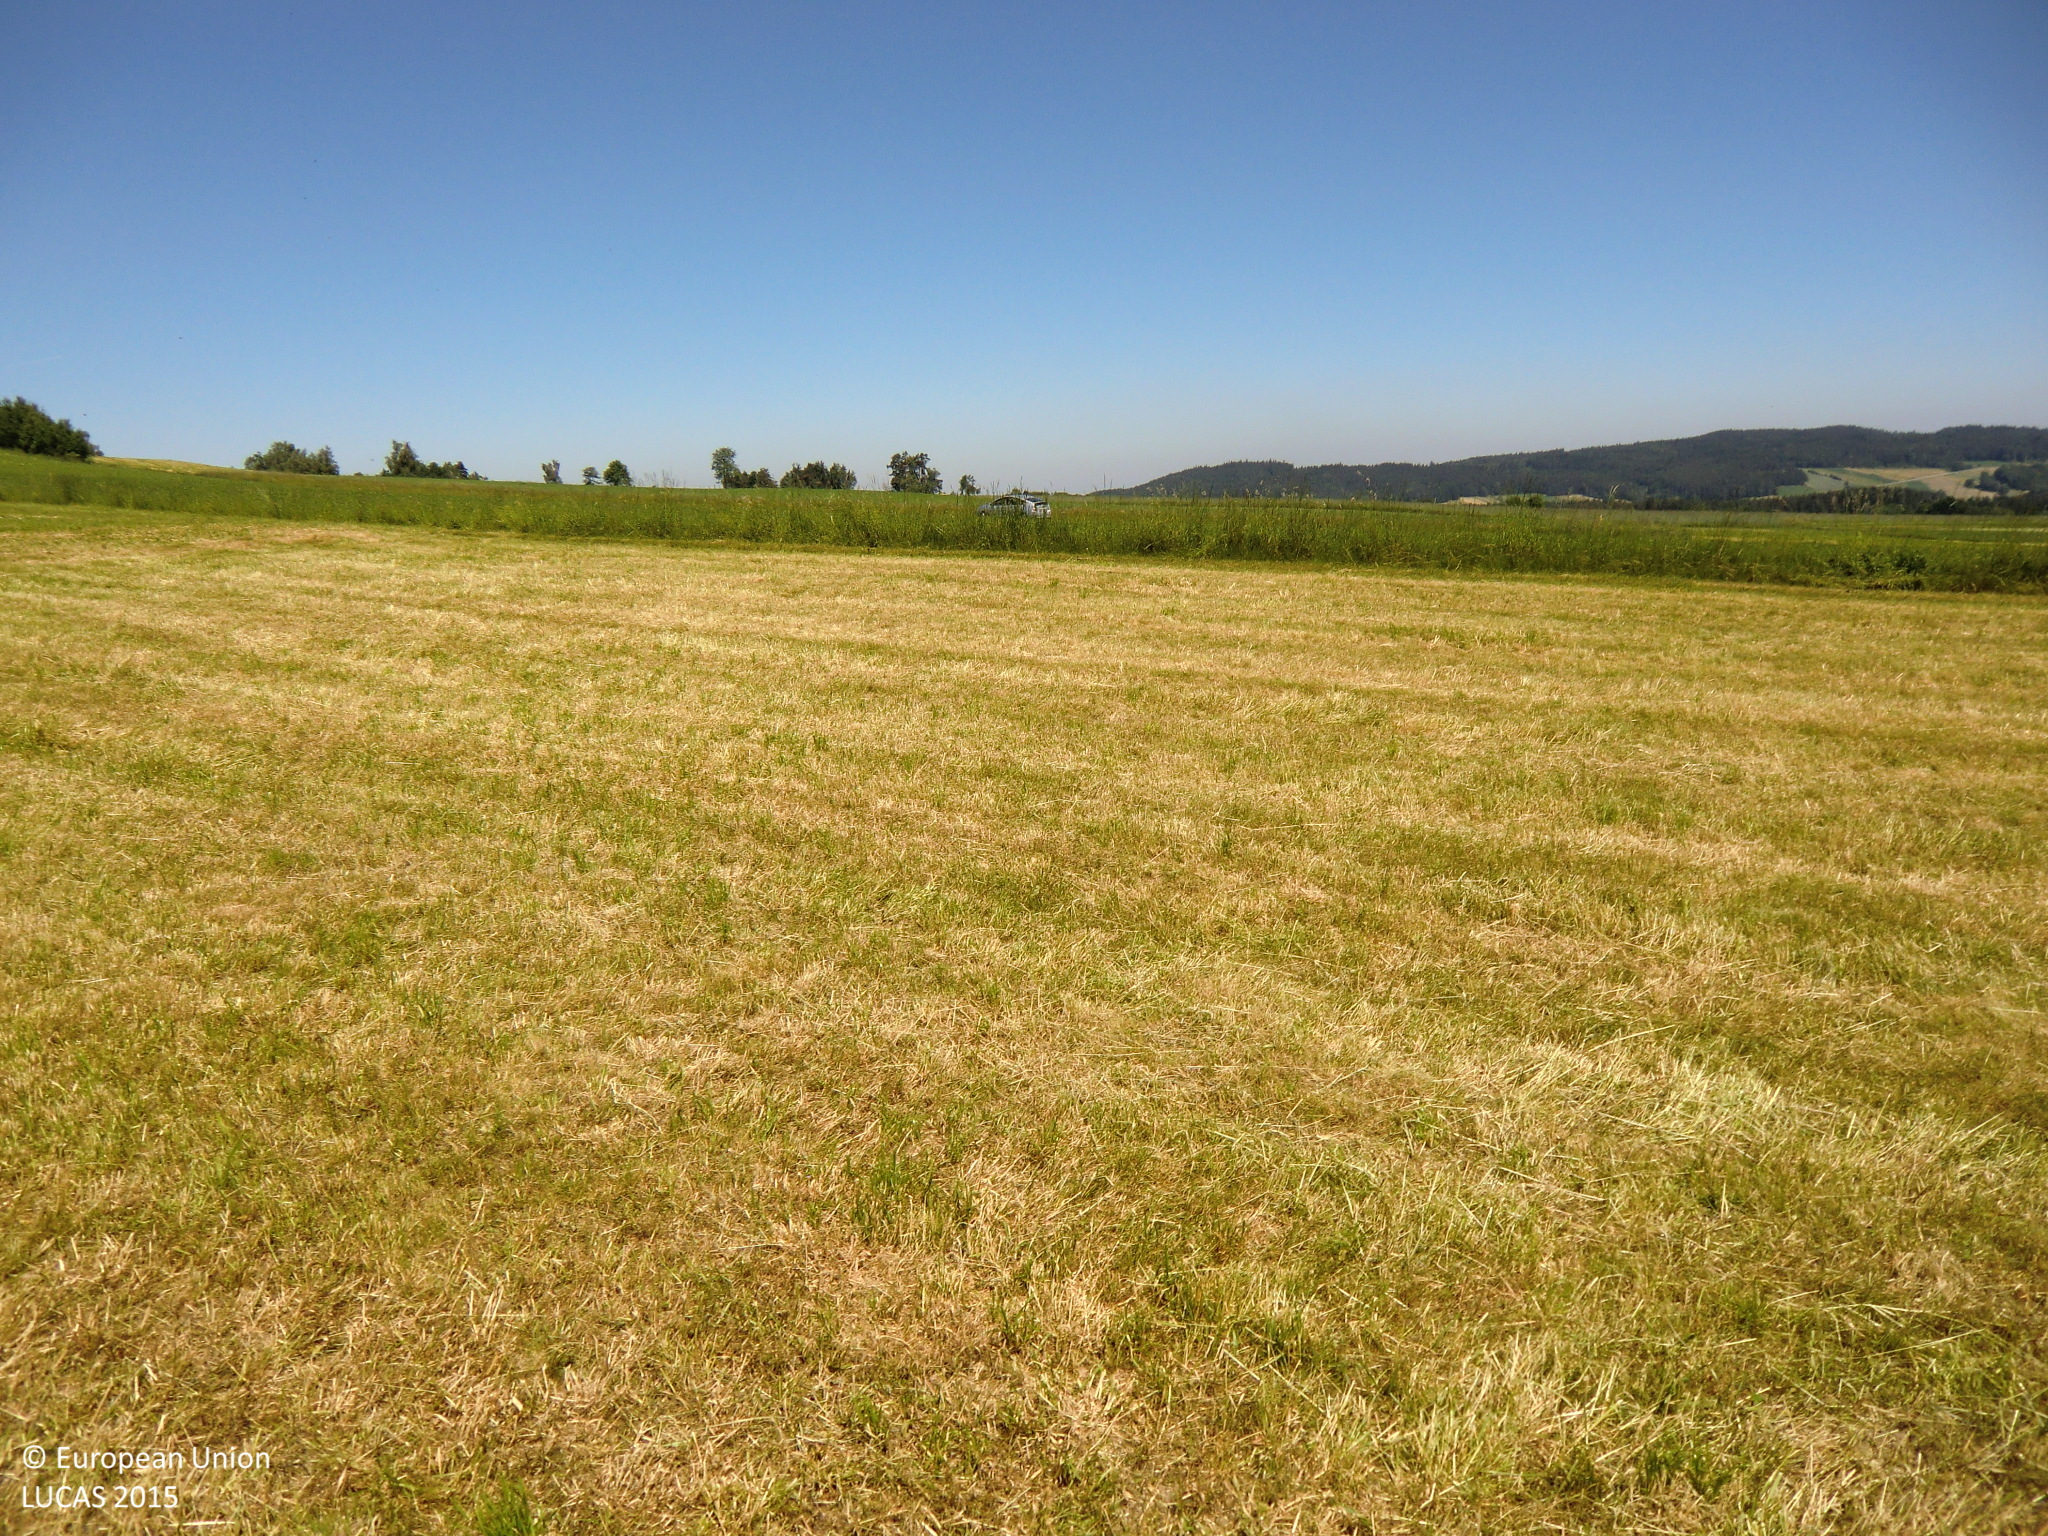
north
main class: Grassland
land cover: Grassland without tree/shrub cover
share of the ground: > 75 %
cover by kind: herbaceous plants 100 %
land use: Agriculture (excluding fallow land and kitchen gardens)
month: June
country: AT
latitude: 48.7486
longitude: 14.8297
